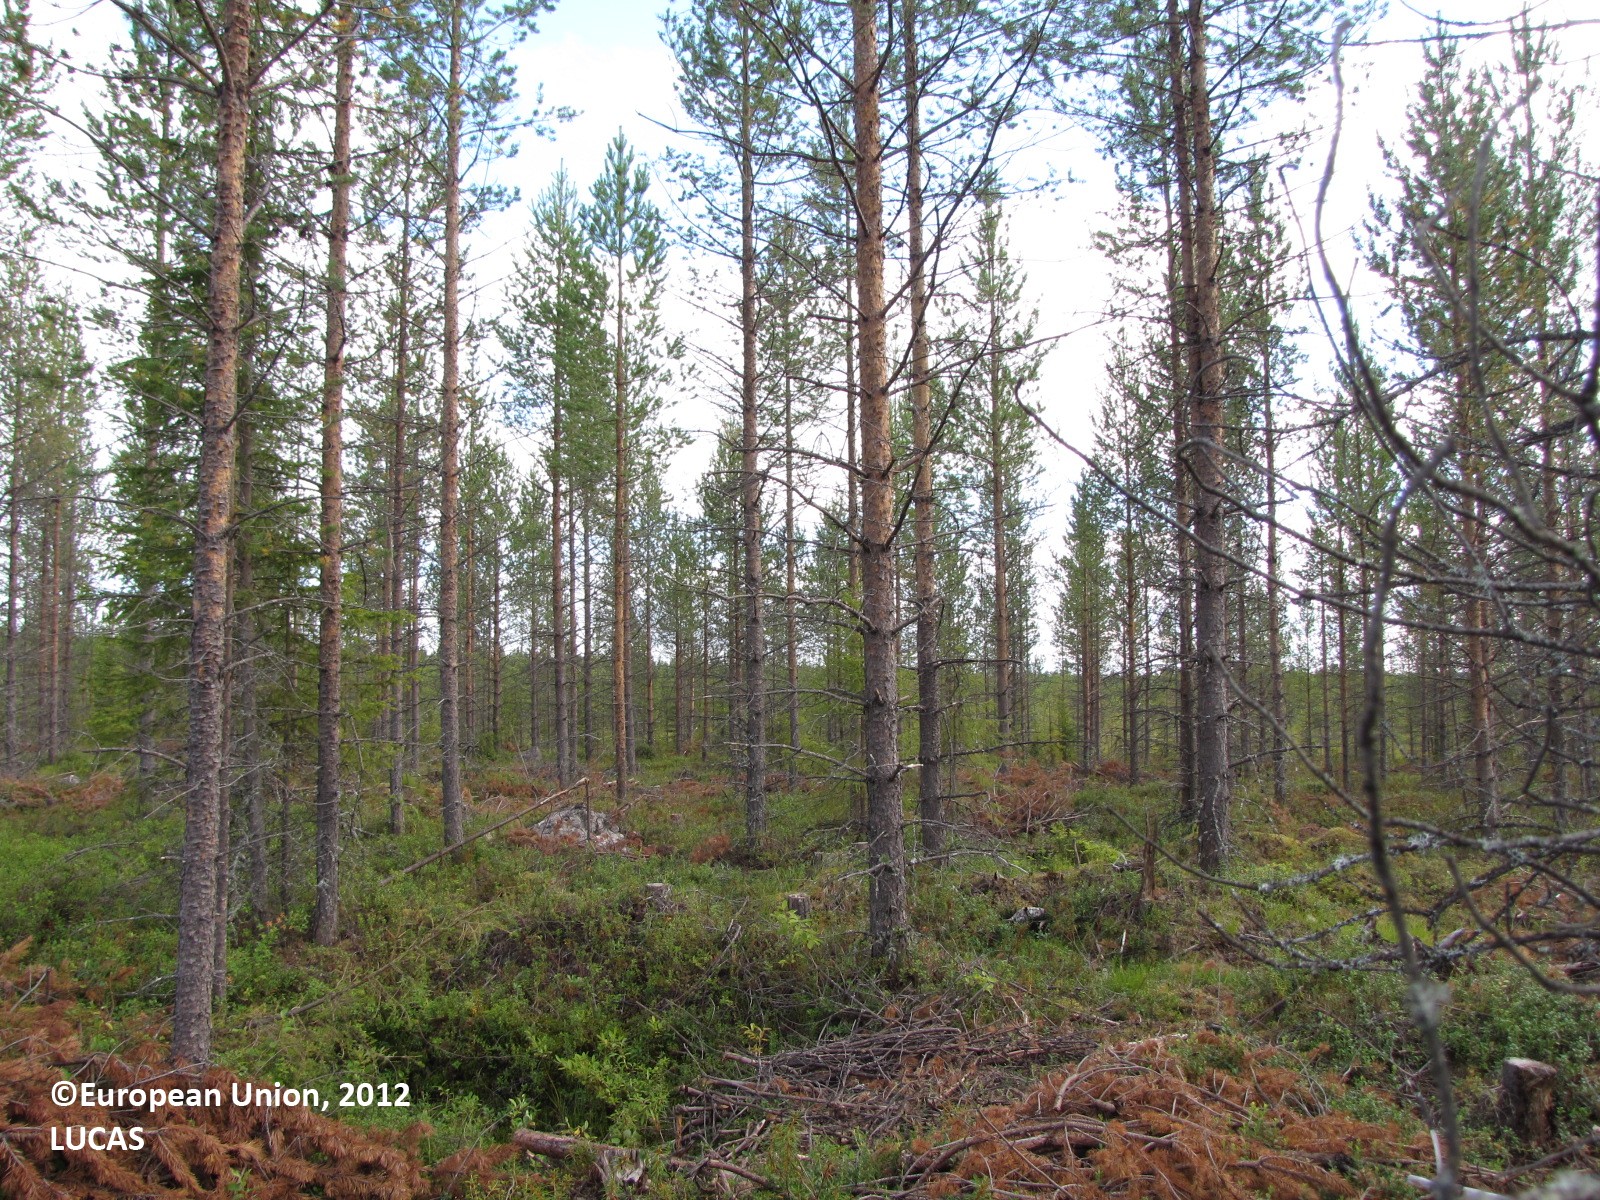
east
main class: Woodland
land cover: Pine dominated coniferous woodland
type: boreal forest
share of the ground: 25 - 50 %
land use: Forestry
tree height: > 5 m
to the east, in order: Pine dominated coniferous woodland; Tracks; Pine dominated coniferous woodland; Tracks; Pine dominated coniferous woodland
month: August
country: FI
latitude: 66.9623
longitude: 25.0938
